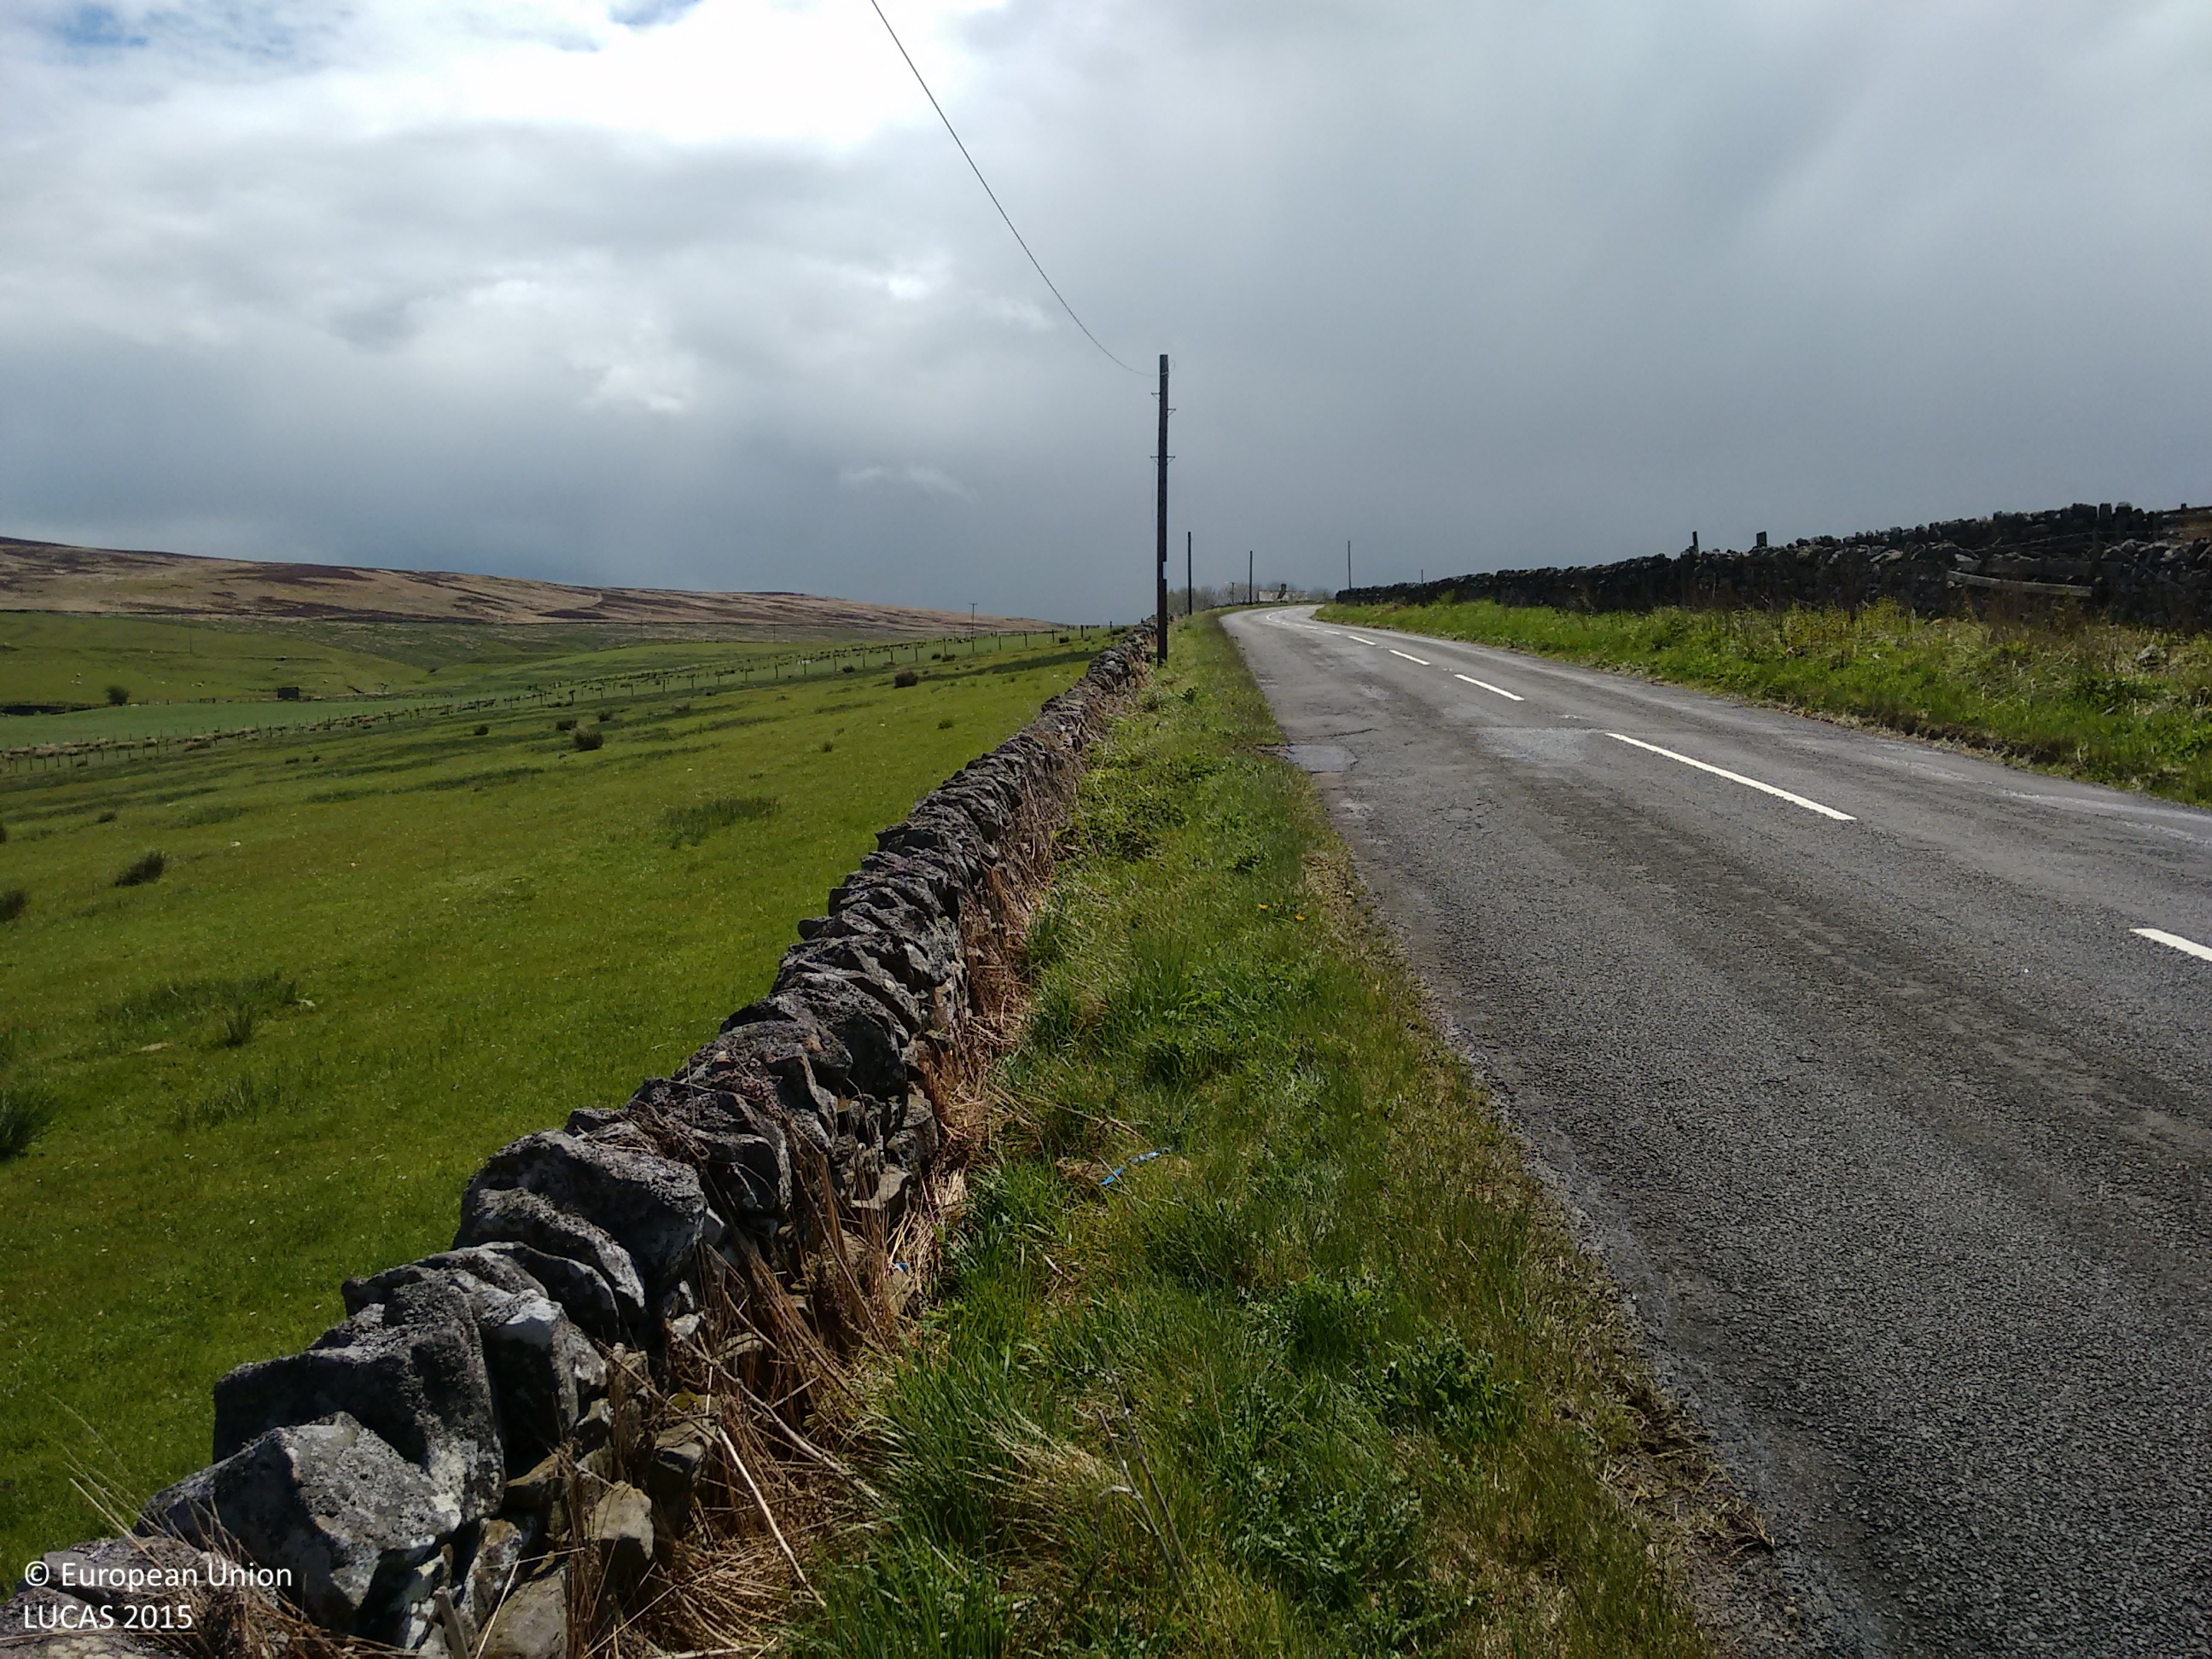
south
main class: Grassland
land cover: Grassland without tree/shrub cover
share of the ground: > 75 %
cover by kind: herbaceous plants 100 %
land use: Agriculture (excluding fallow land and kitchen gardens)
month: May
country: GB
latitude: 55.1785
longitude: -2.2592
